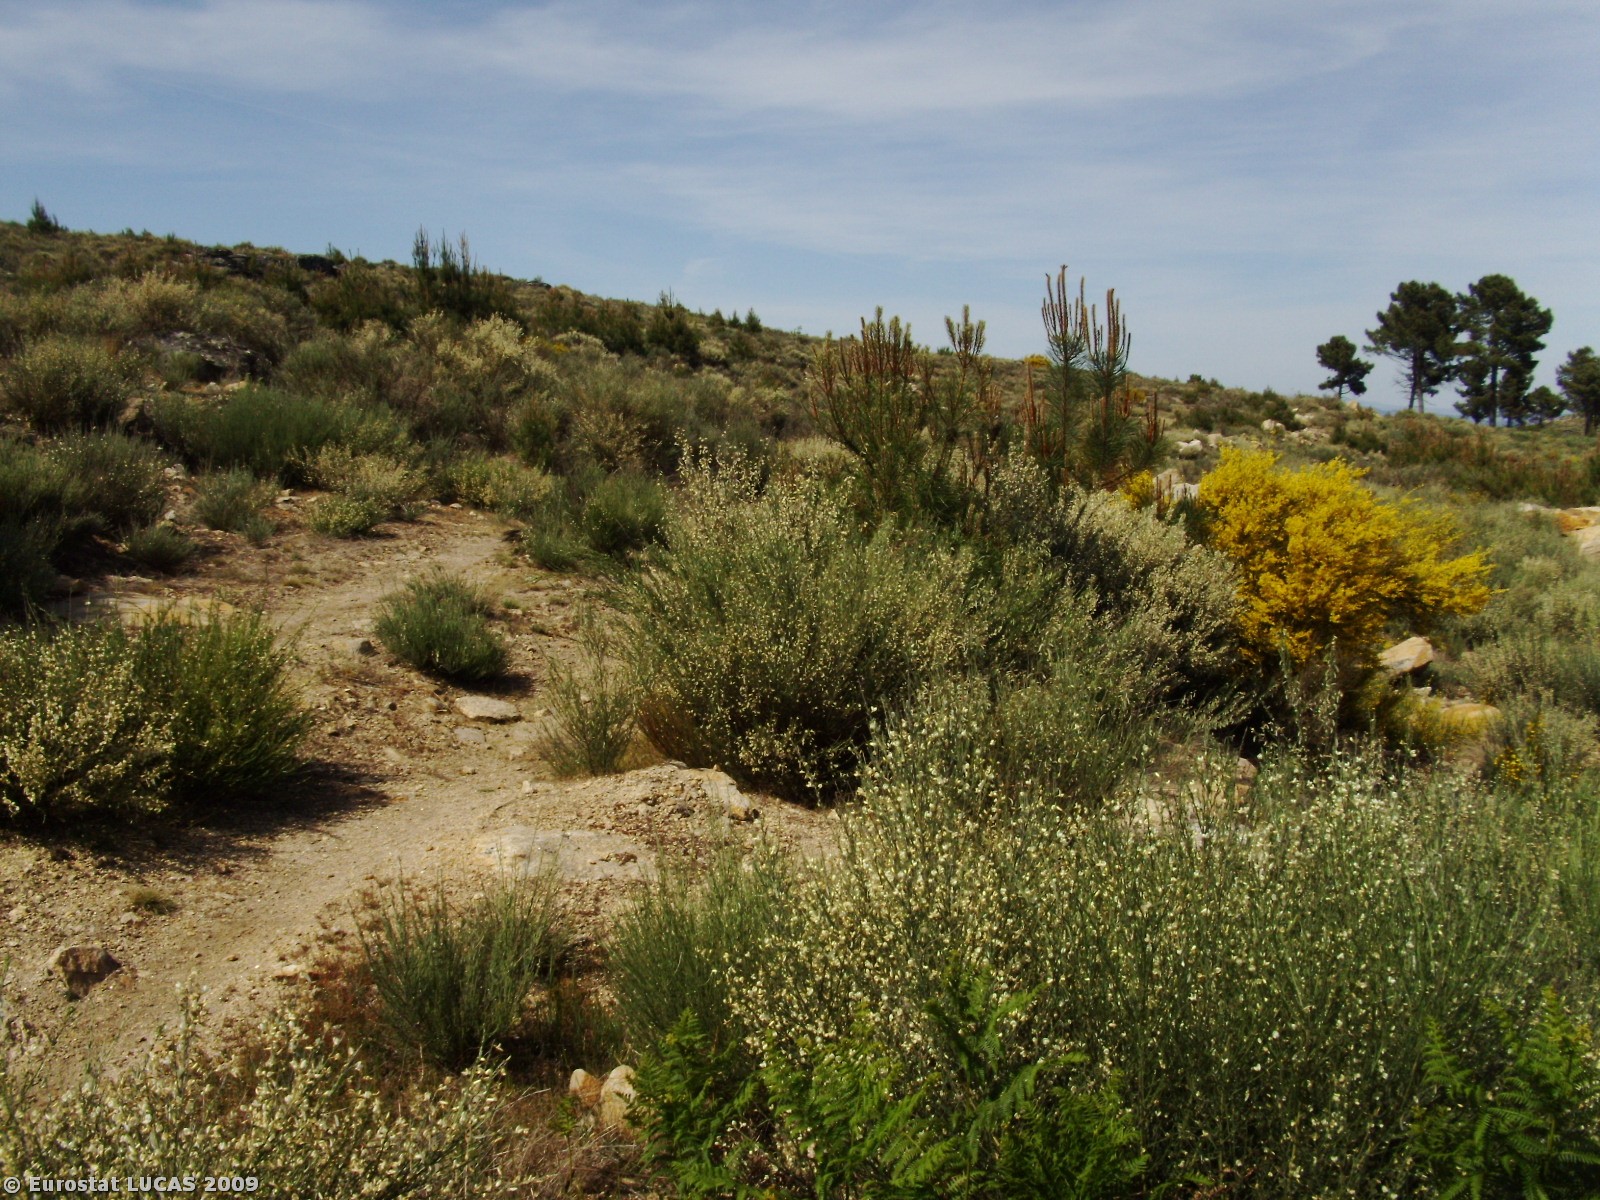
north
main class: Woodland
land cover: Coniferous woodland
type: coniferous forest of the mediterranean region
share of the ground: > 75 %
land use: Forestry
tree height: > 5 m
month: May
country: PT
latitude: 40.9405
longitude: -7.3492
